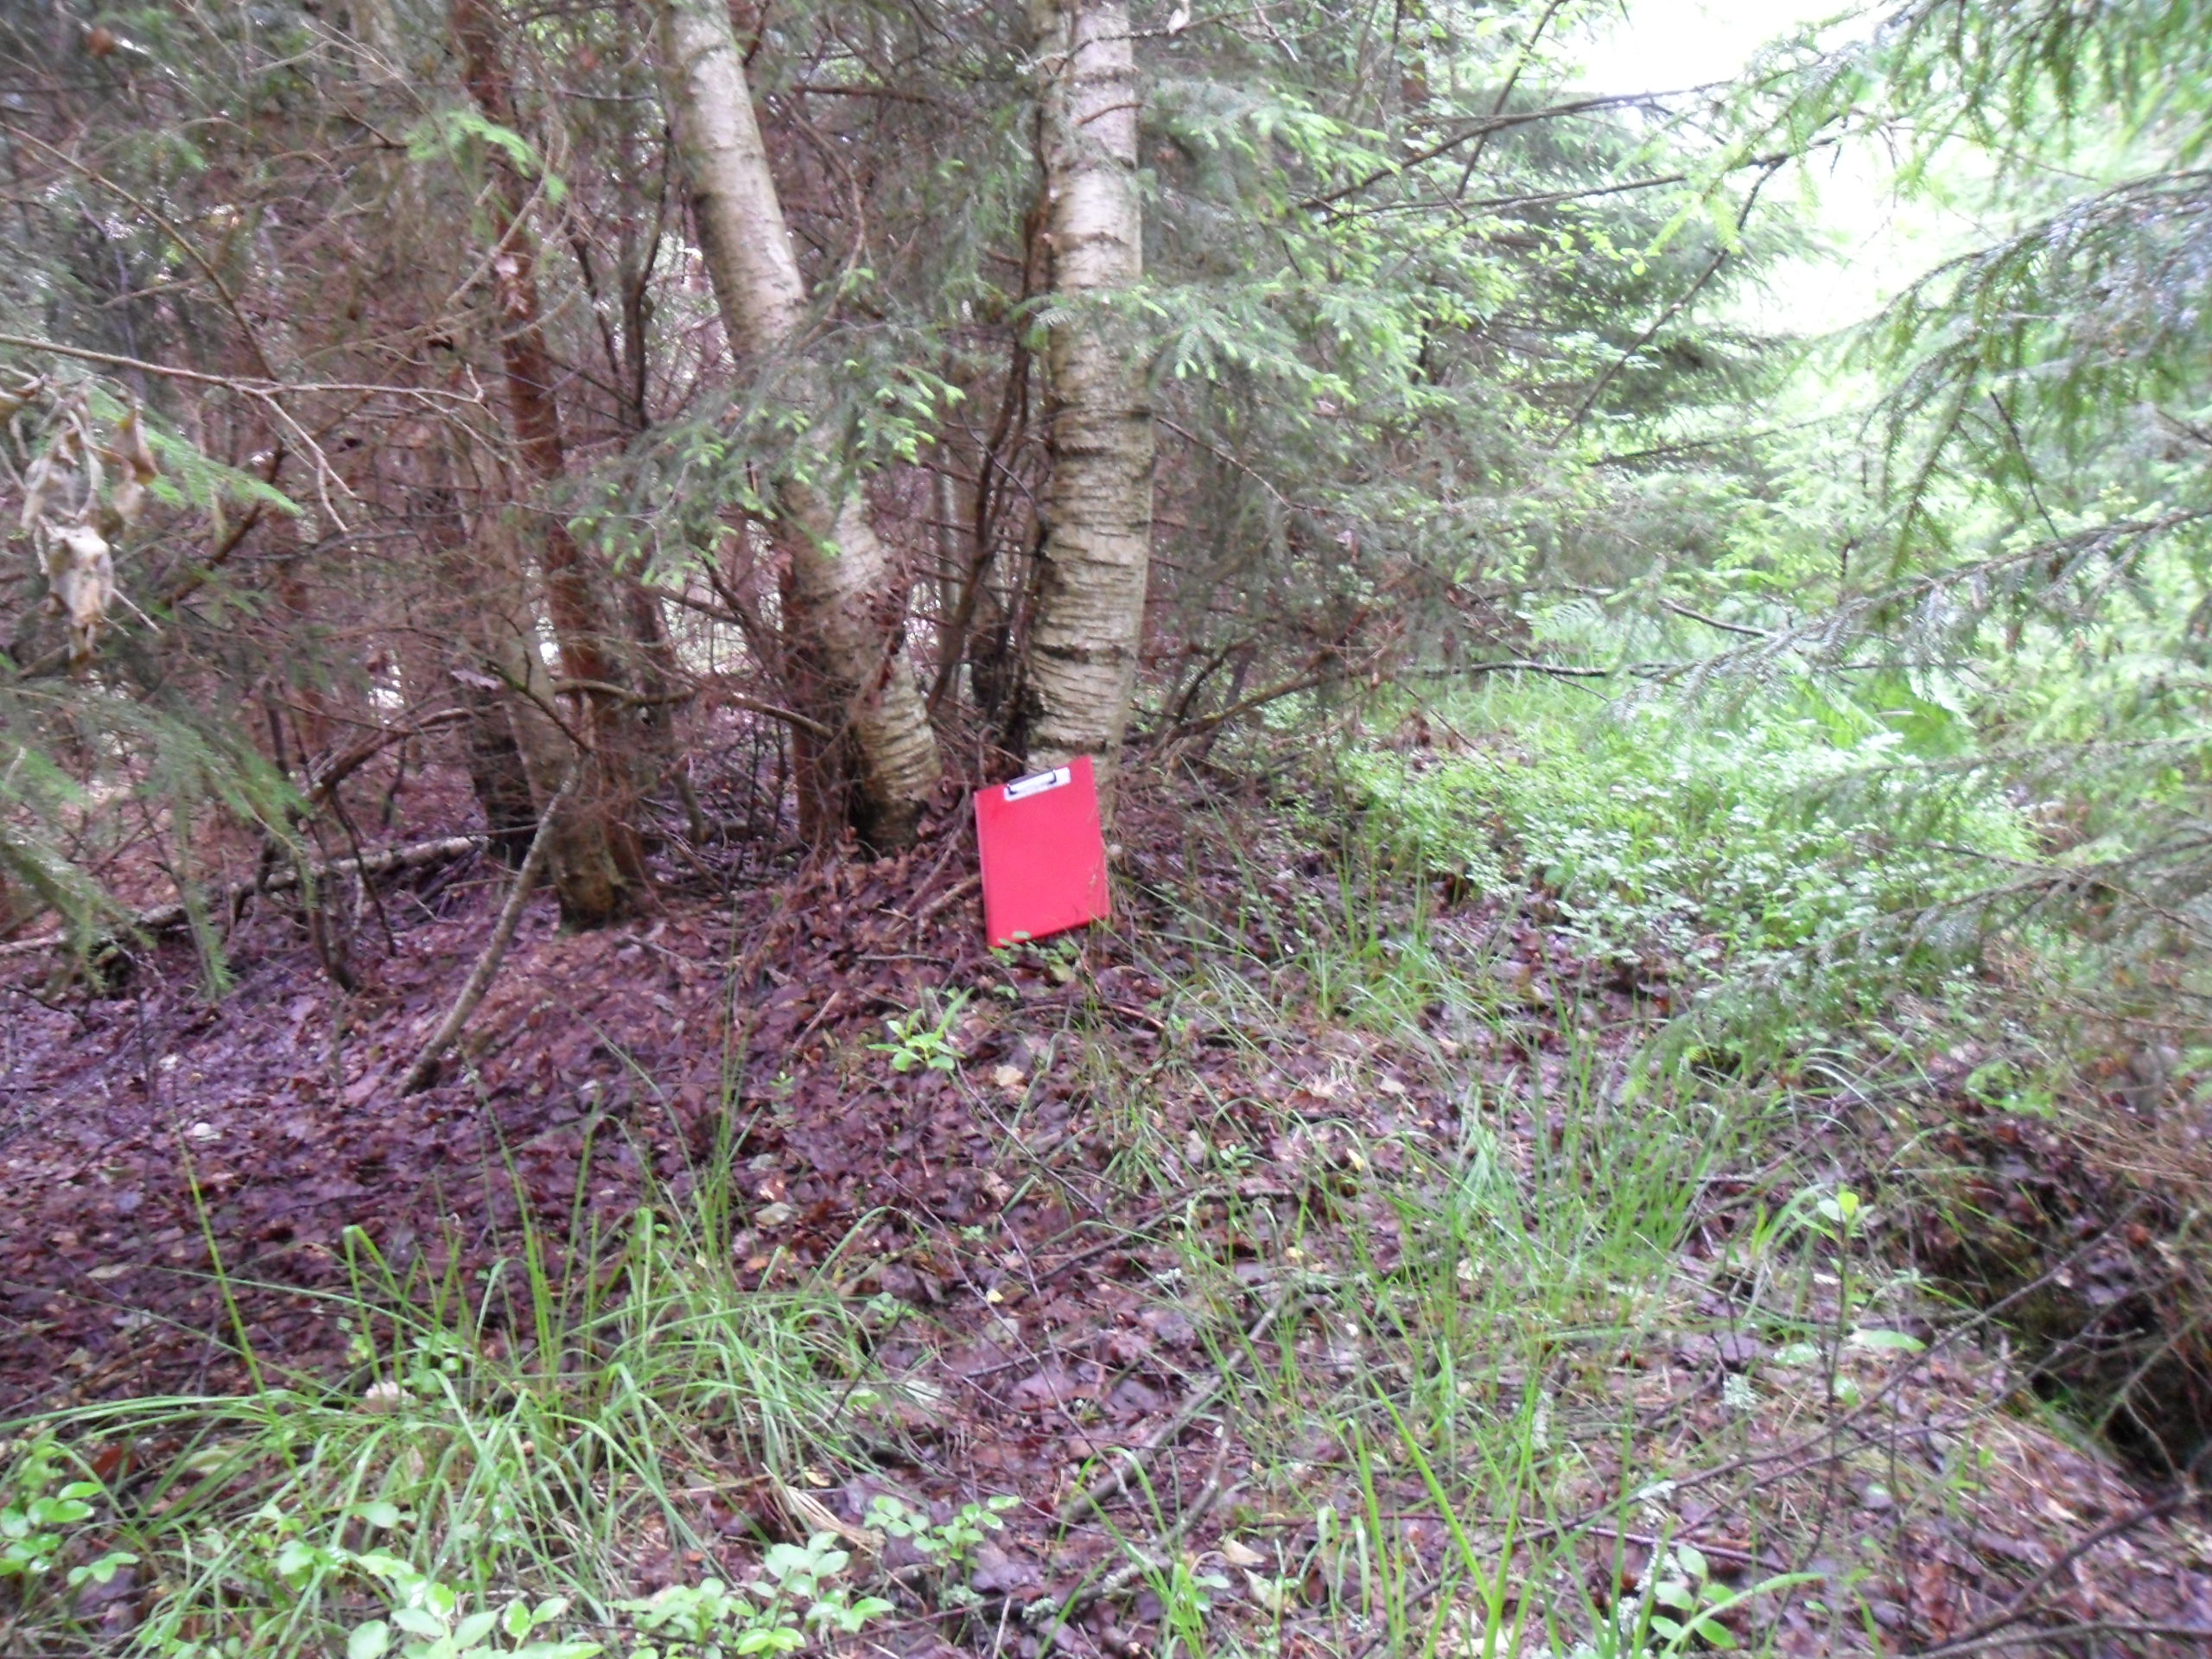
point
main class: Woodland
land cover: Spruce dominated mixed woodland
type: hemiboreal forest and nemoral coniferous forest and mixed broadleaved-coniferous forest
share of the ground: > 75 %
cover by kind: coniferous forest trees 50 %, broadleaved forest trees 30 %, herbaceous plants 20 %
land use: Forestry
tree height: > 5 m
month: June
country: LV
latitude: 57.3935
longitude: 21.9414
